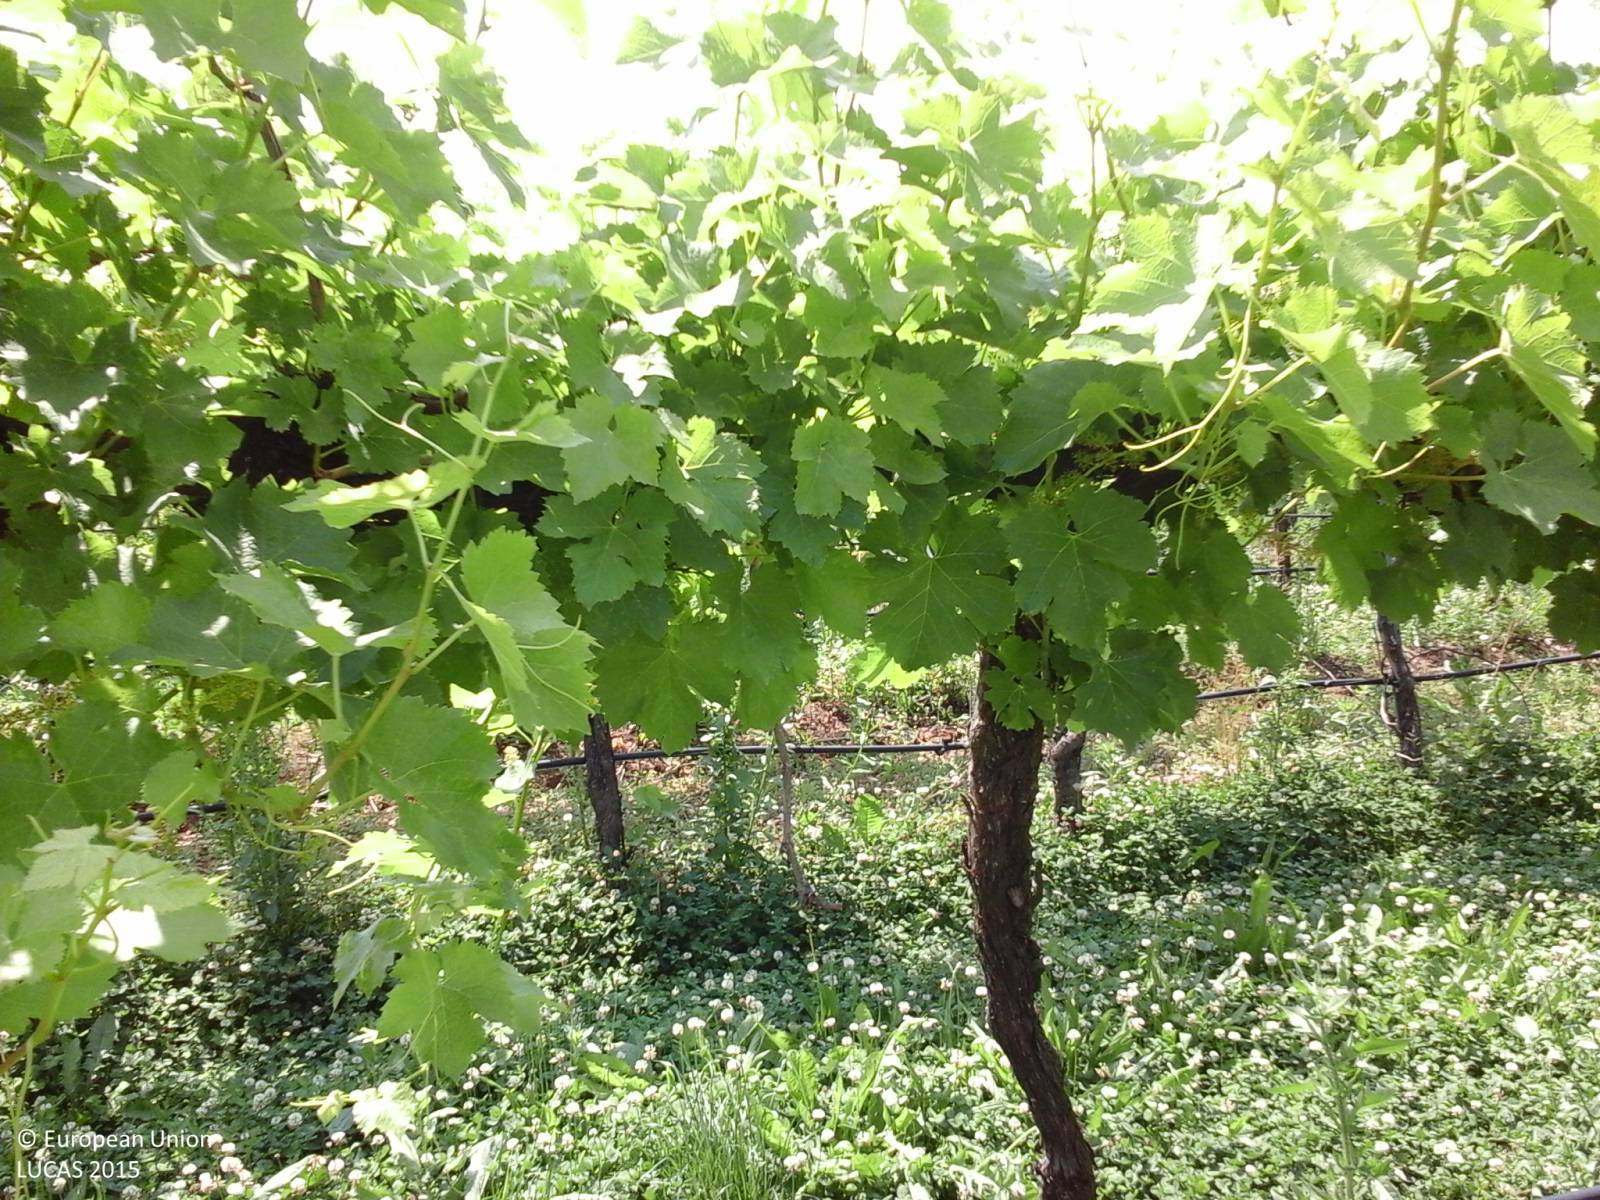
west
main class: Cropland
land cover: Vineyards
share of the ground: > 75 %
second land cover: Grassland without tree/shrub cover
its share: > 75 %
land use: Agriculture (excluding fallow land and kitchen gardens)
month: June
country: IT
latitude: 45.9370
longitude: 13.3883
